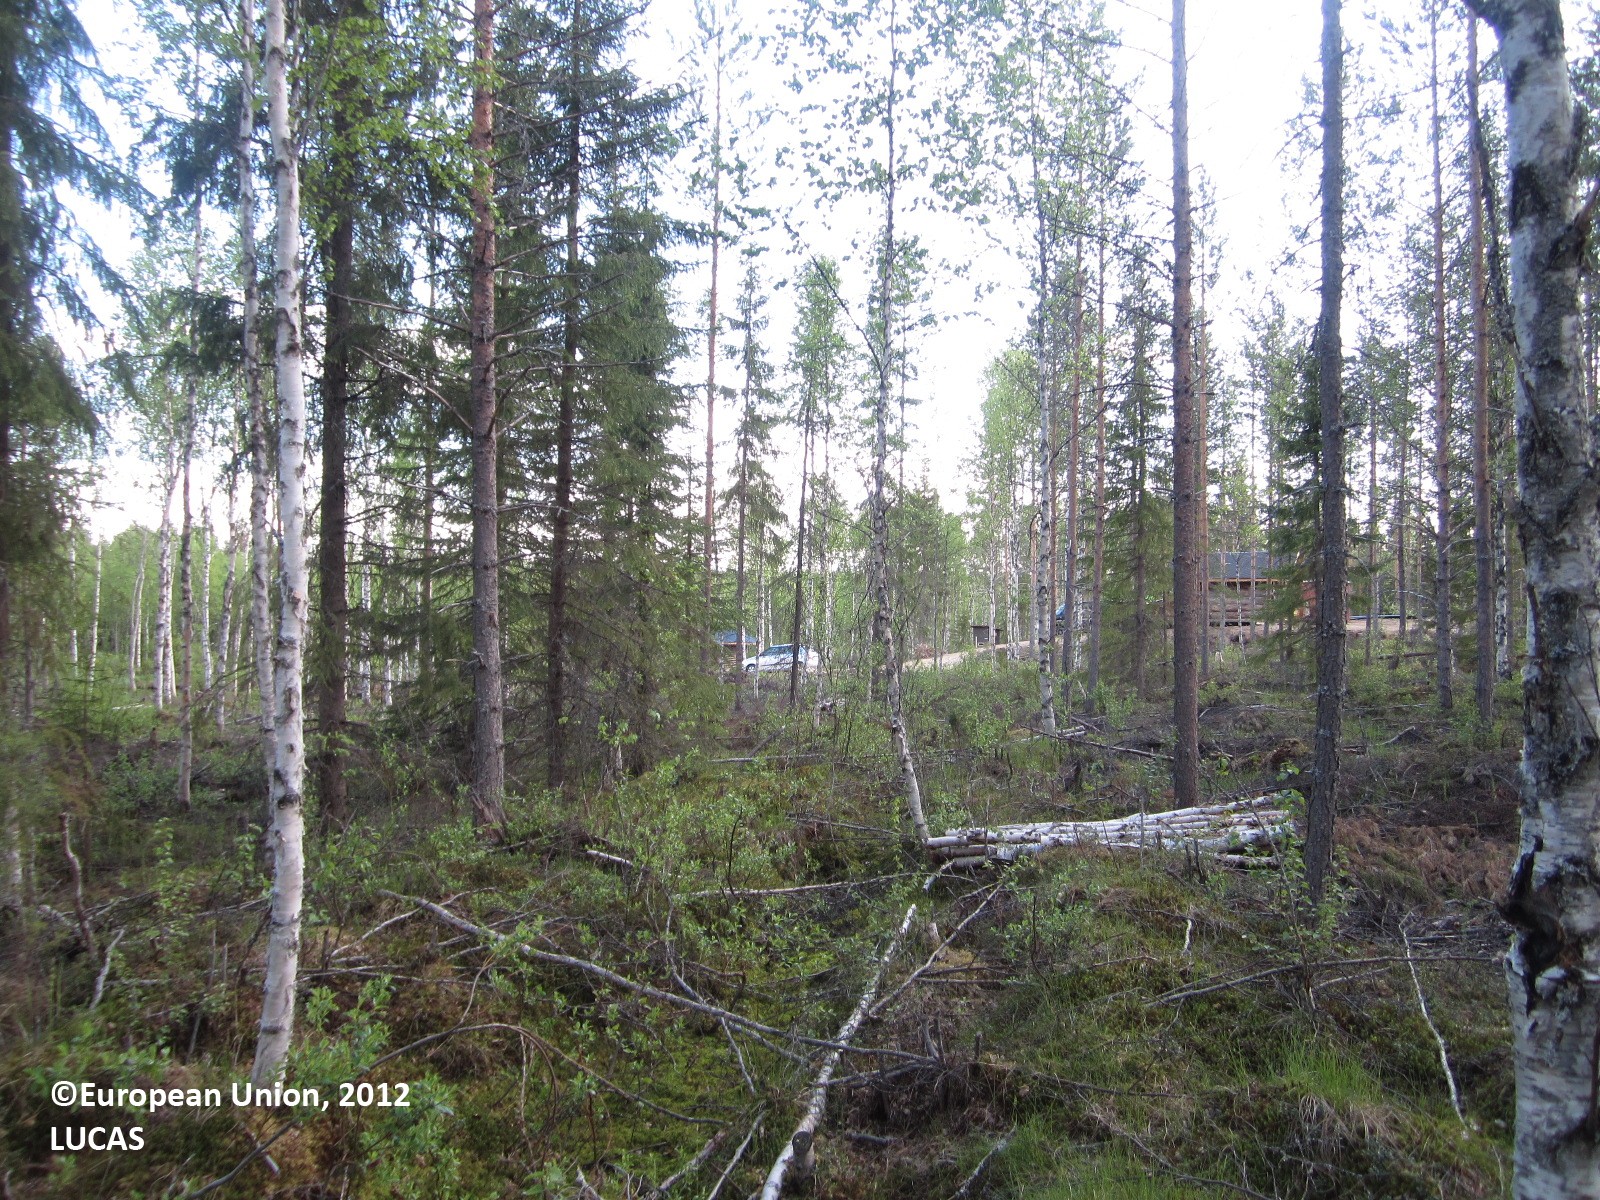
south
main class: Woodland
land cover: Pine dominated mixed woodland
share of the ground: 25 - 50 %
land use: Forestry
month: June
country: FI
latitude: 64.6422
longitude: 28.7887
